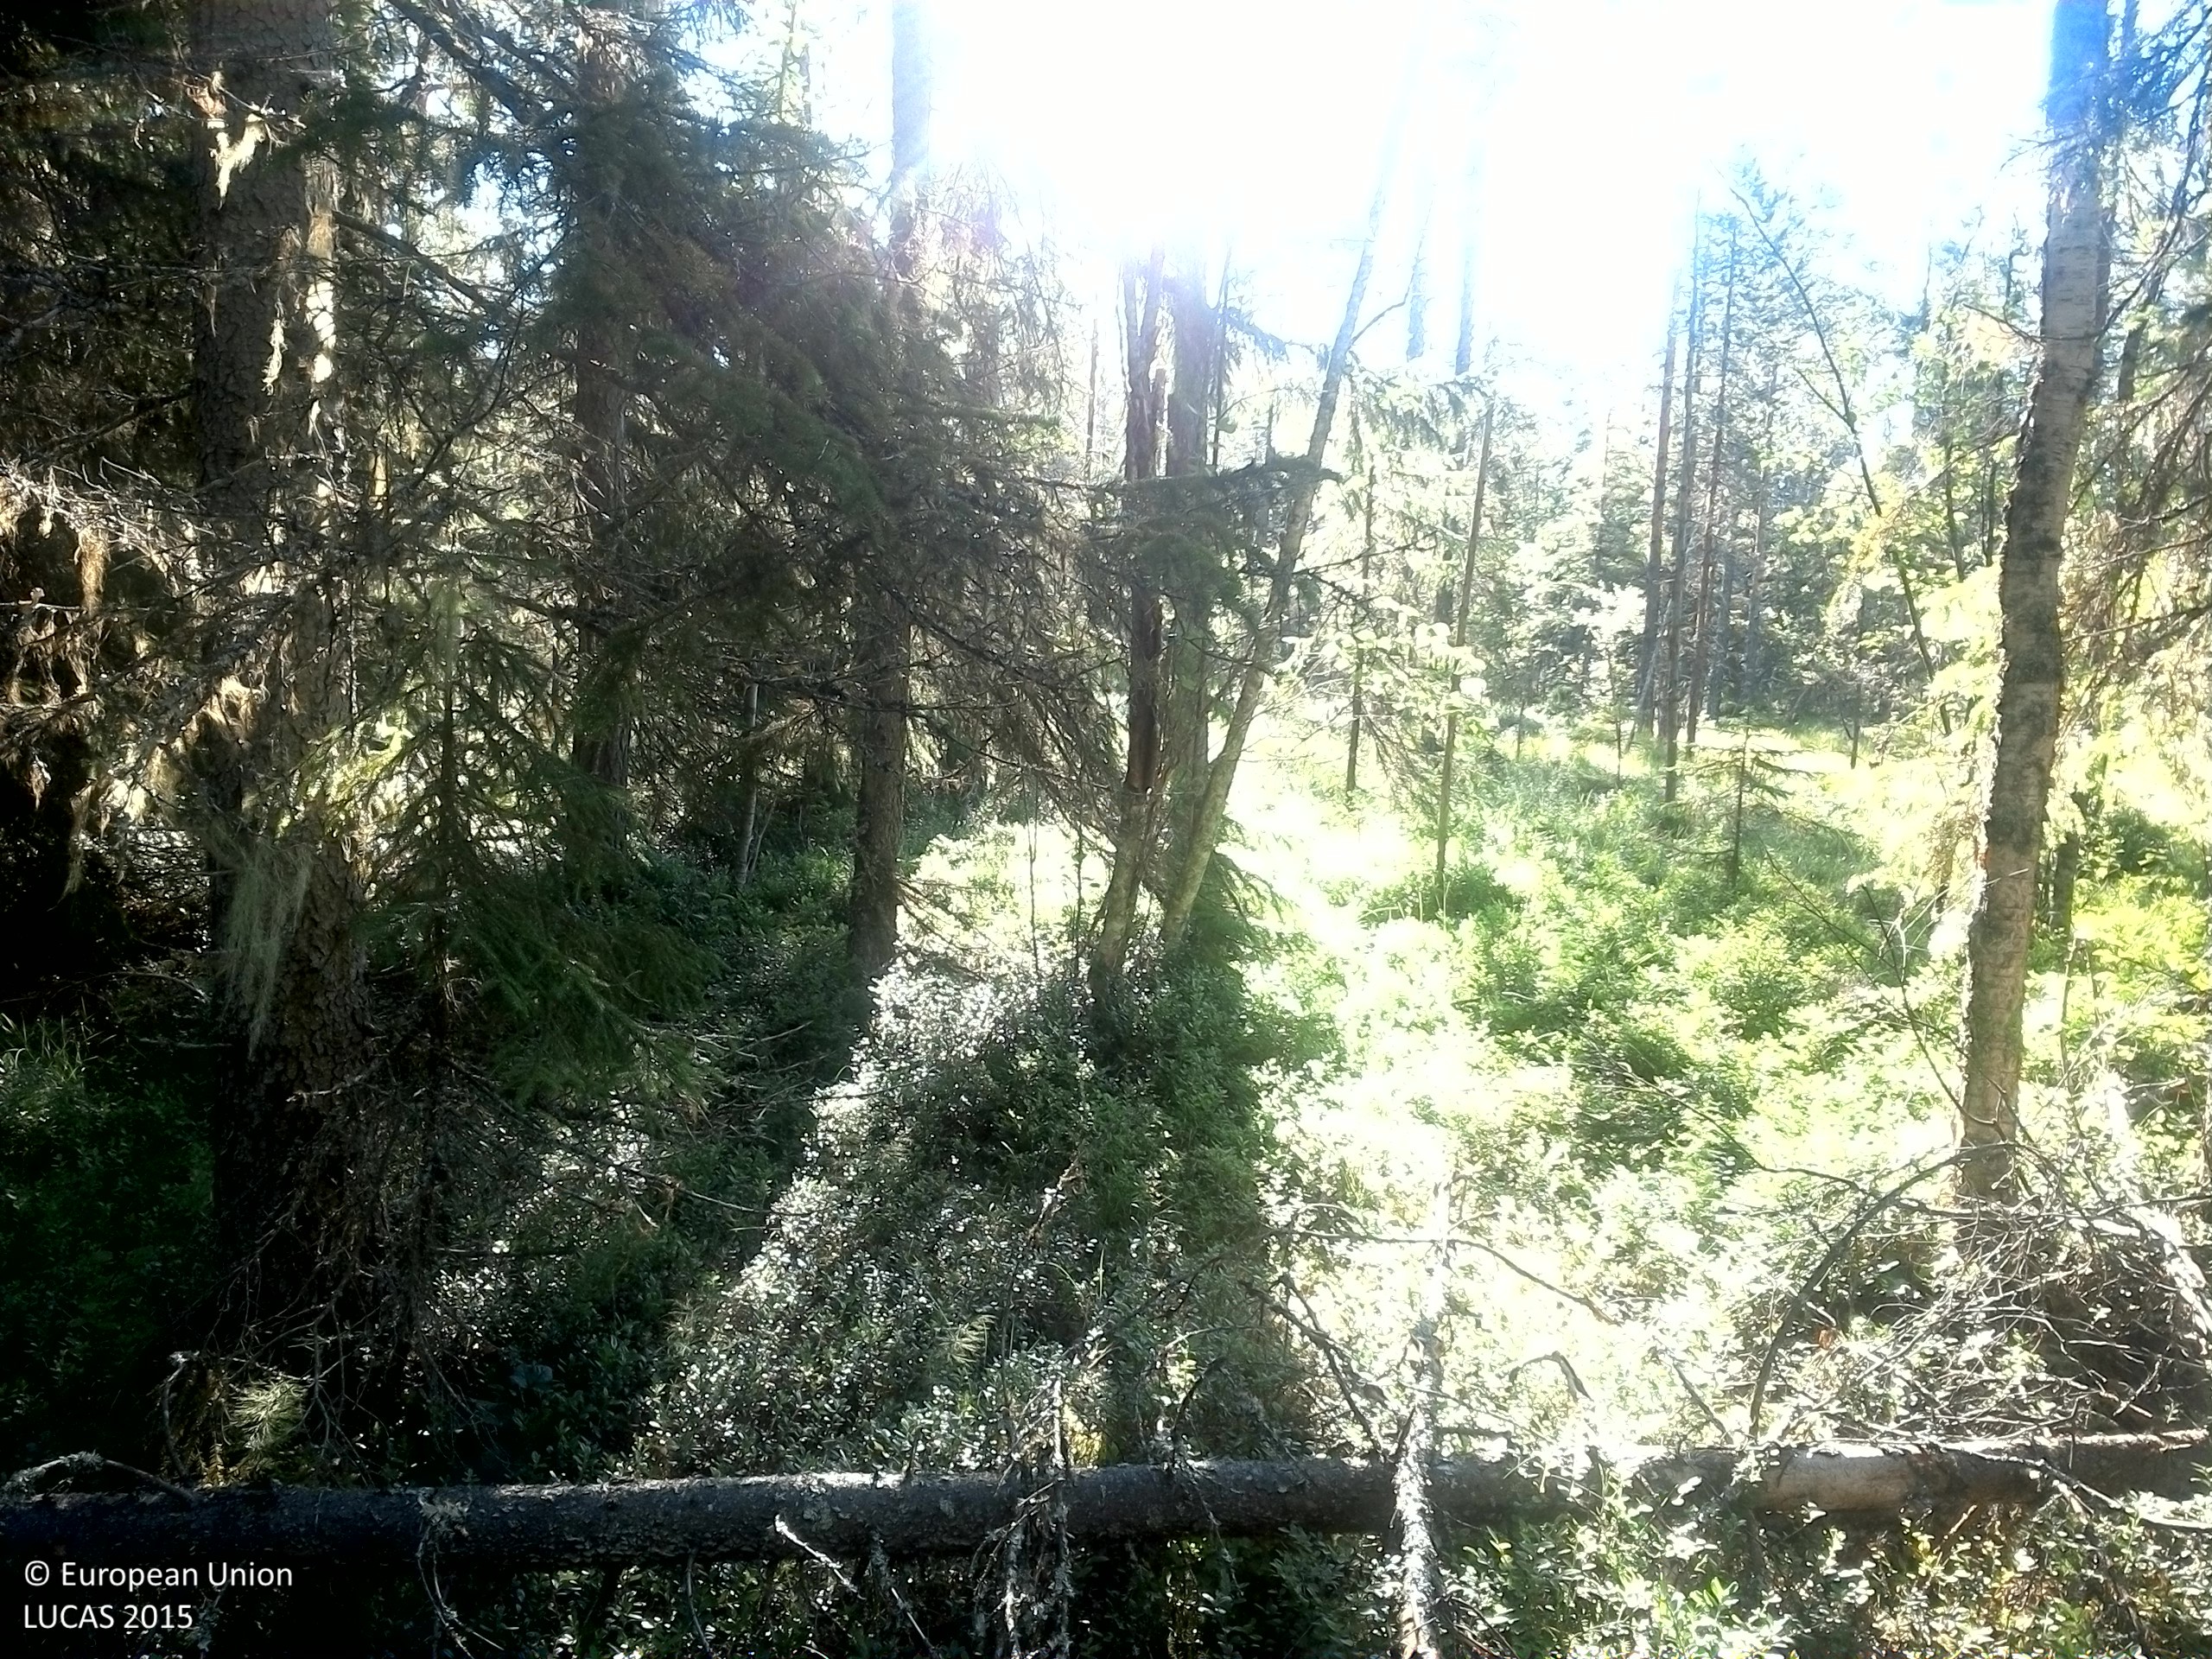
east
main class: Woodland
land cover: Spruce dominated coniferous woodland
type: boreal forest
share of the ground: 25 - 50 %
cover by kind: coniferous forest trees 40 %, shrubs 40 %, herbaceous plants 15 %, broadleaved forest trees 5 %
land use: Forestry
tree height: > 5 m
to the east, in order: Spruce dominated coniferous woodland; Pine dominated mixed woodland; Spruce dominated mixed woodland; Pine dominated coniferous woodland; Spruce dominated coniferous woodland; Pine dominated mixed woodland
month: August
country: SE
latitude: 63.7697
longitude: 16.6440
